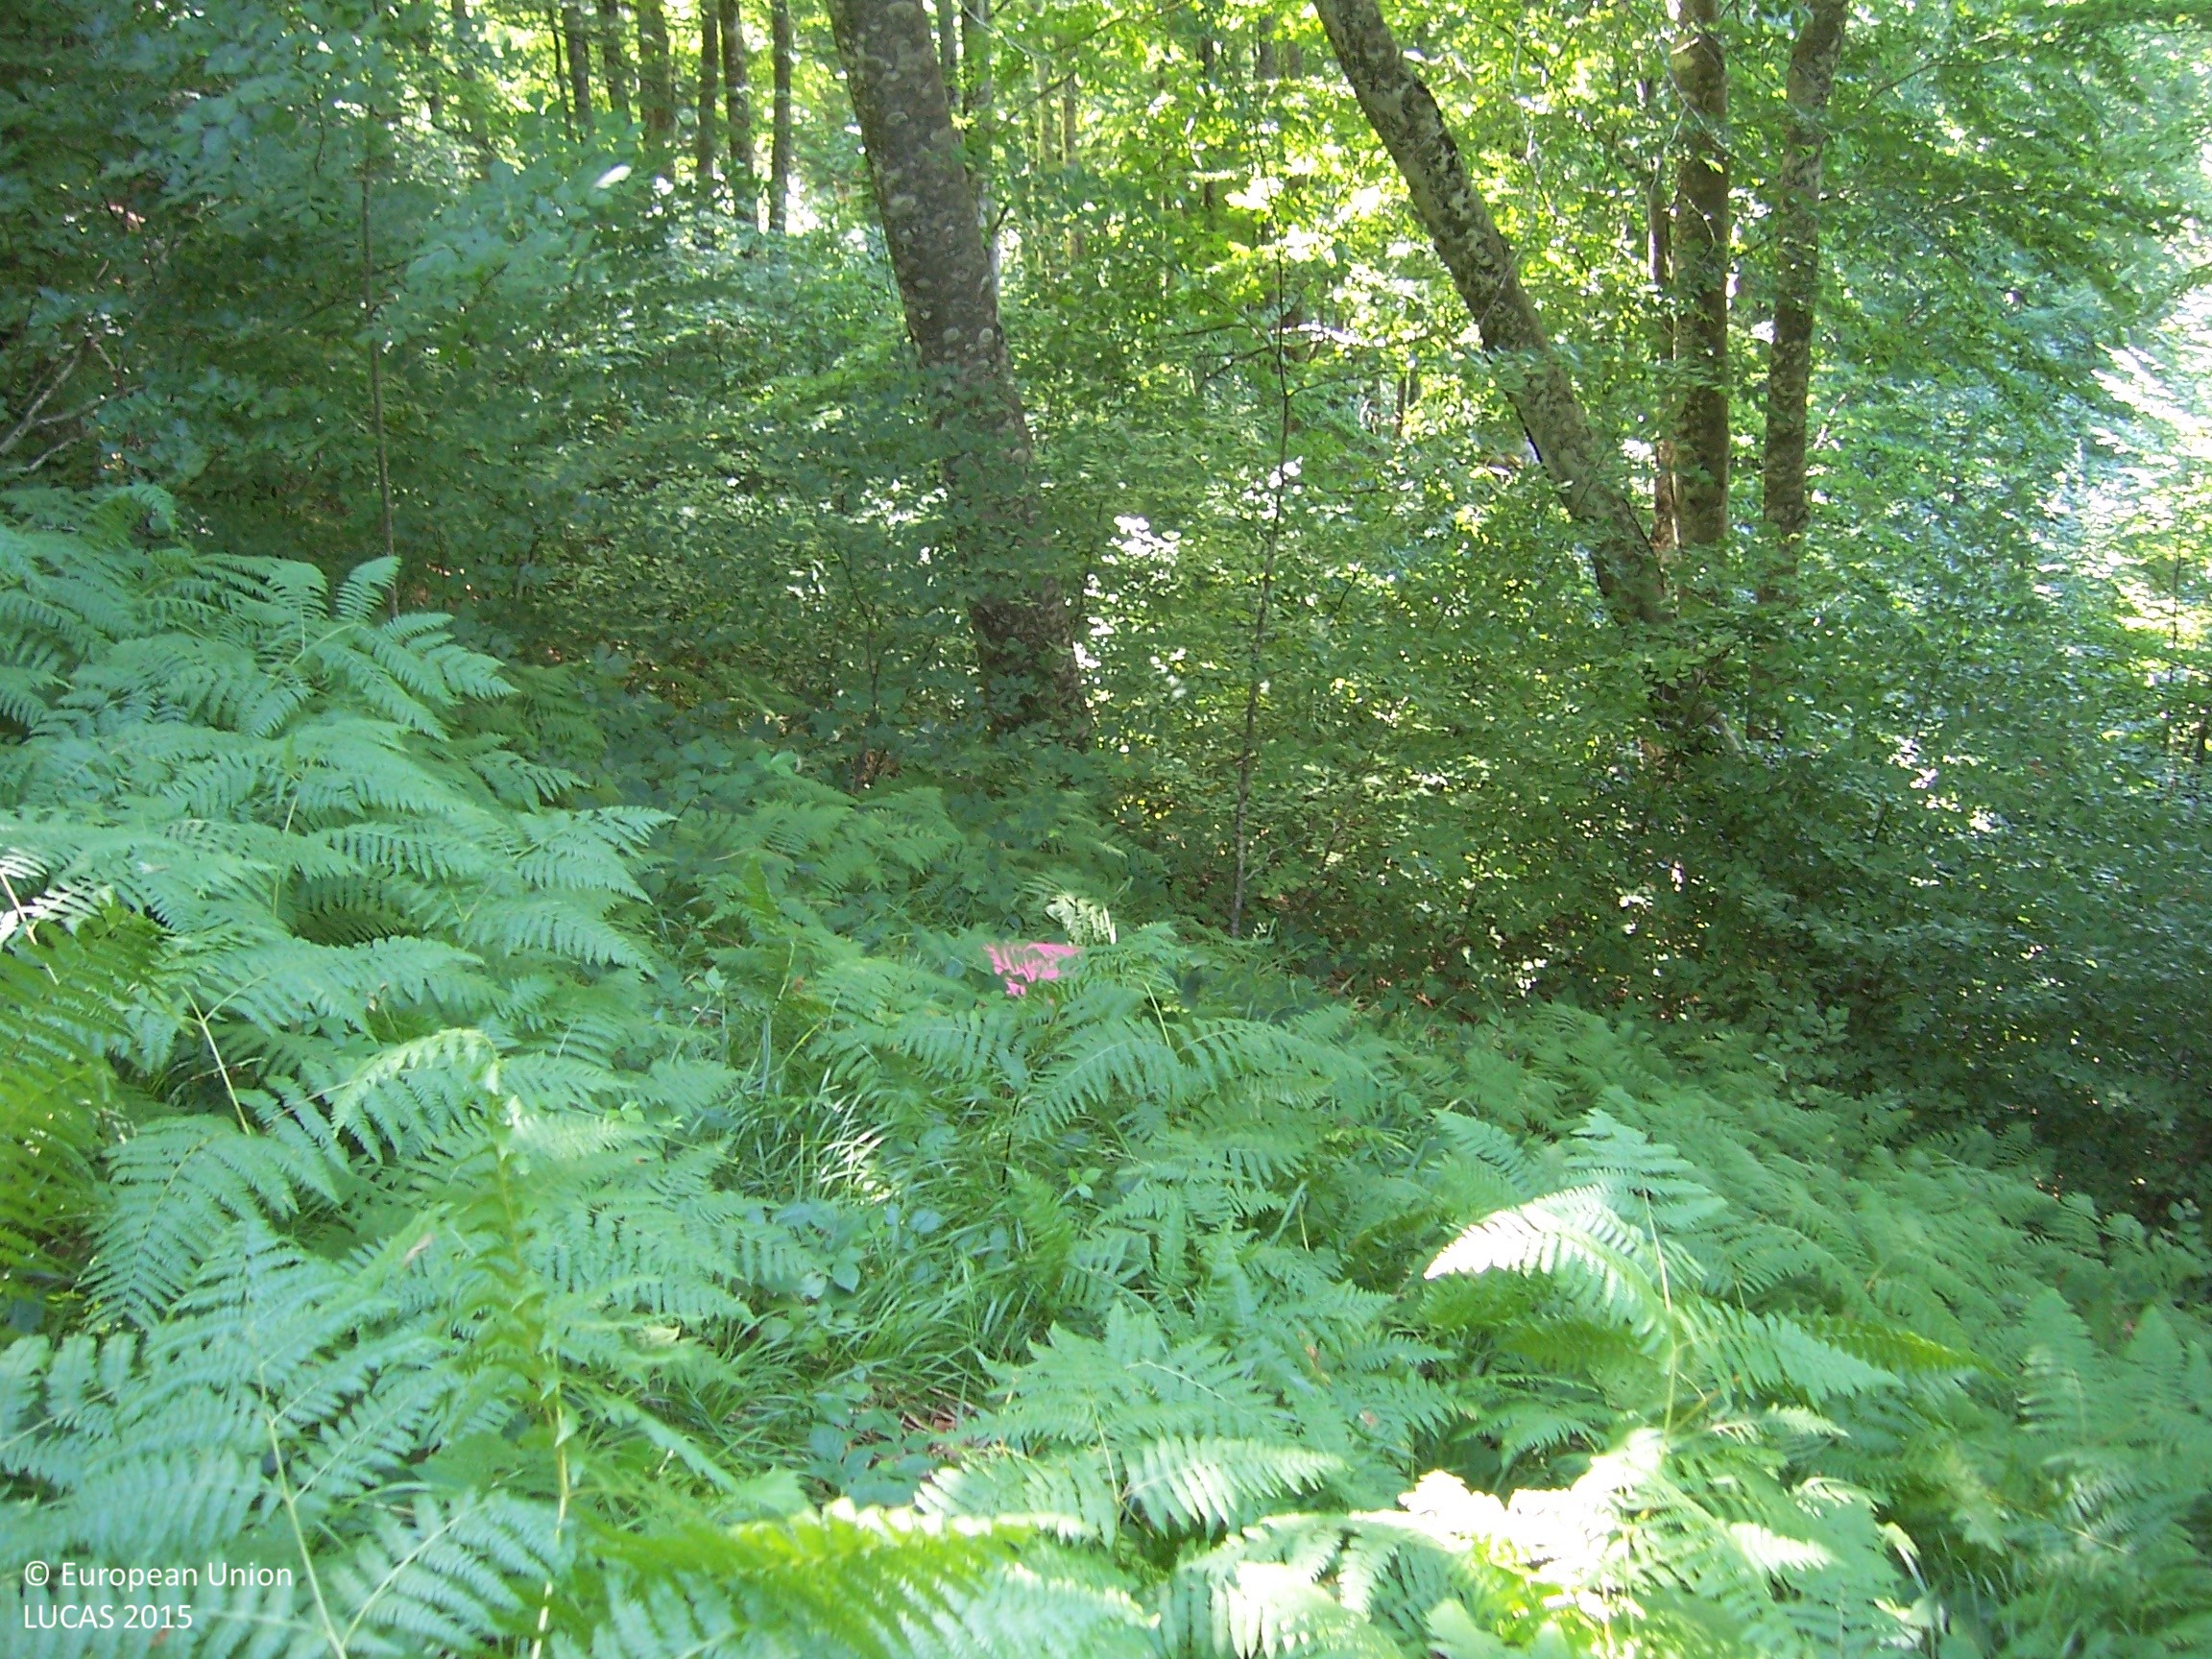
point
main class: Woodland
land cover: Broadleaved woodland
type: mountainous beech forest
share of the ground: > 75 %
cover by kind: broadleaved forest trees 100 %
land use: Forestry
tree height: > 5 m
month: July
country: ES
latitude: 42.9236
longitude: -1.1968
